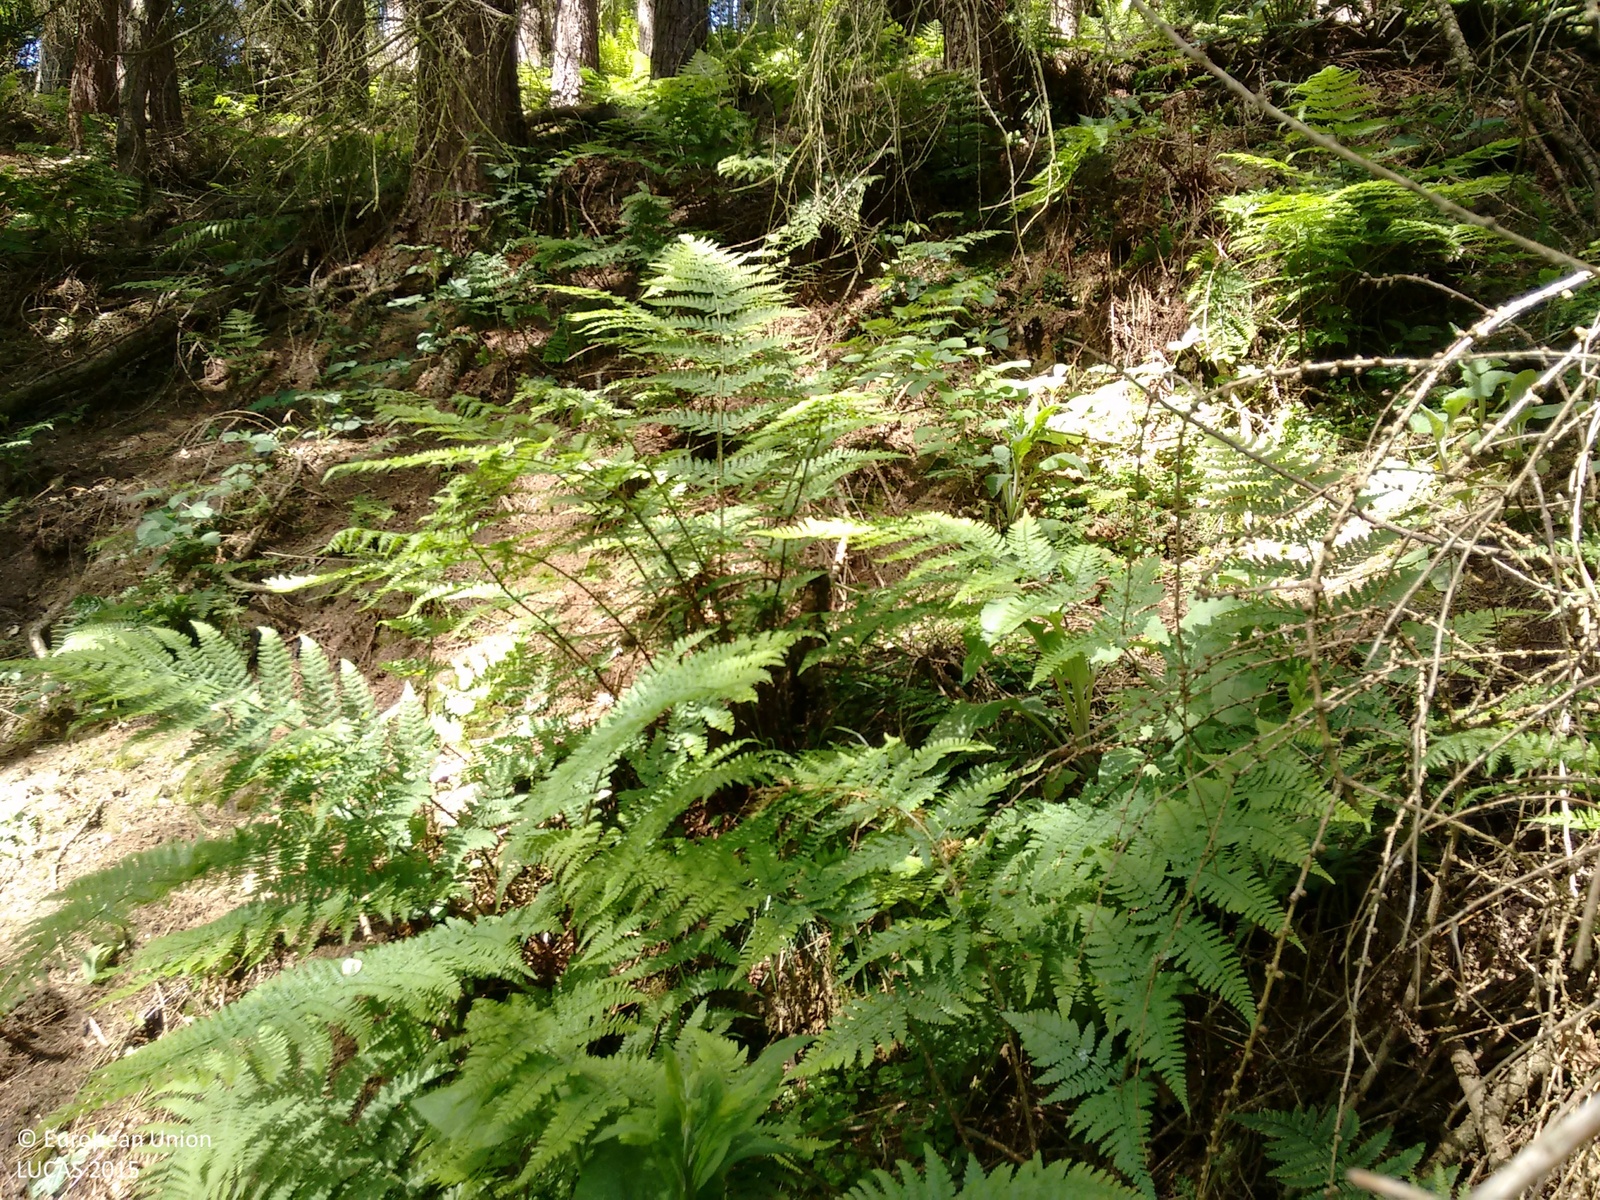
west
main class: Woodland
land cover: Other mixed woodland
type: mesophytic deciduous forest
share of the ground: > 75 %
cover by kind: coniferous forest trees 50 %, broadleaved forest trees 50 %
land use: Sport
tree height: > 5 m
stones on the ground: < 10 %
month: June
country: GB
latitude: 54.2247
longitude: -1.1959
